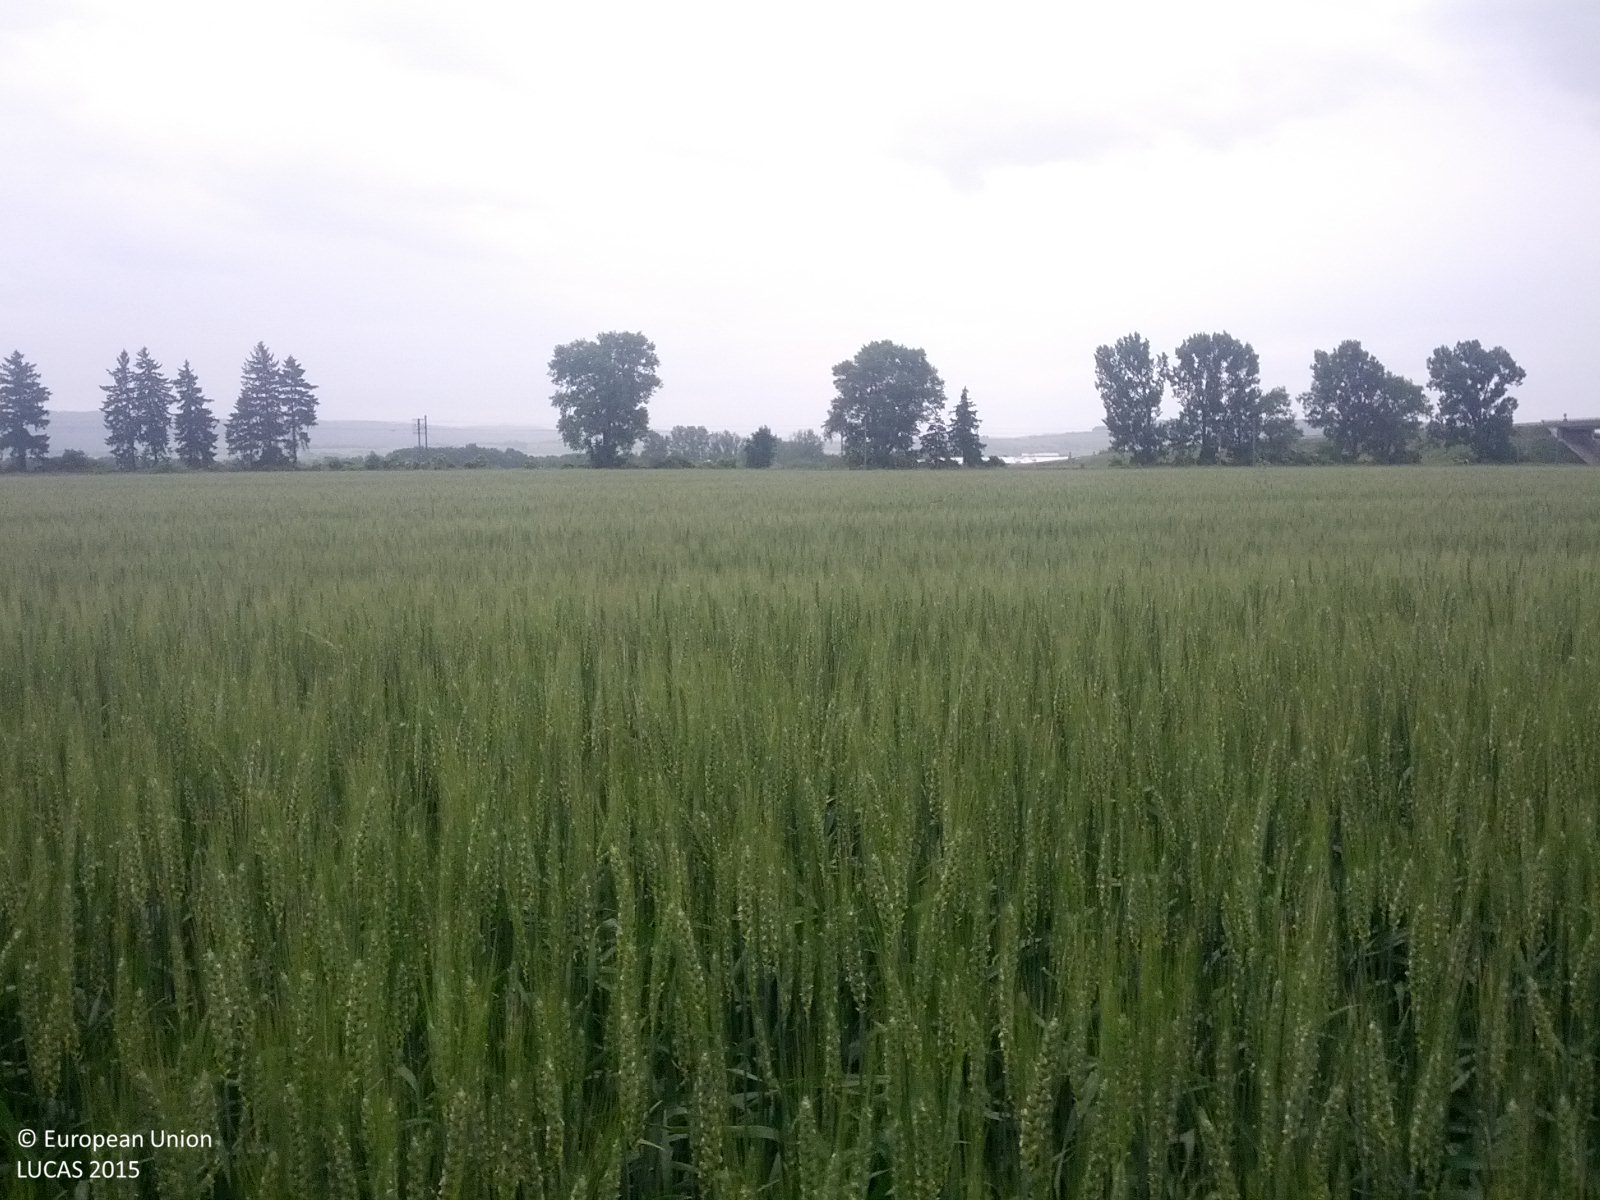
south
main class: Cropland
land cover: Durum wheat
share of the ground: > 75 %
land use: Agriculture (excluding fallow land and kitchen gardens)
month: May
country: AT
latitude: 48.3260
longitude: 16.0872
